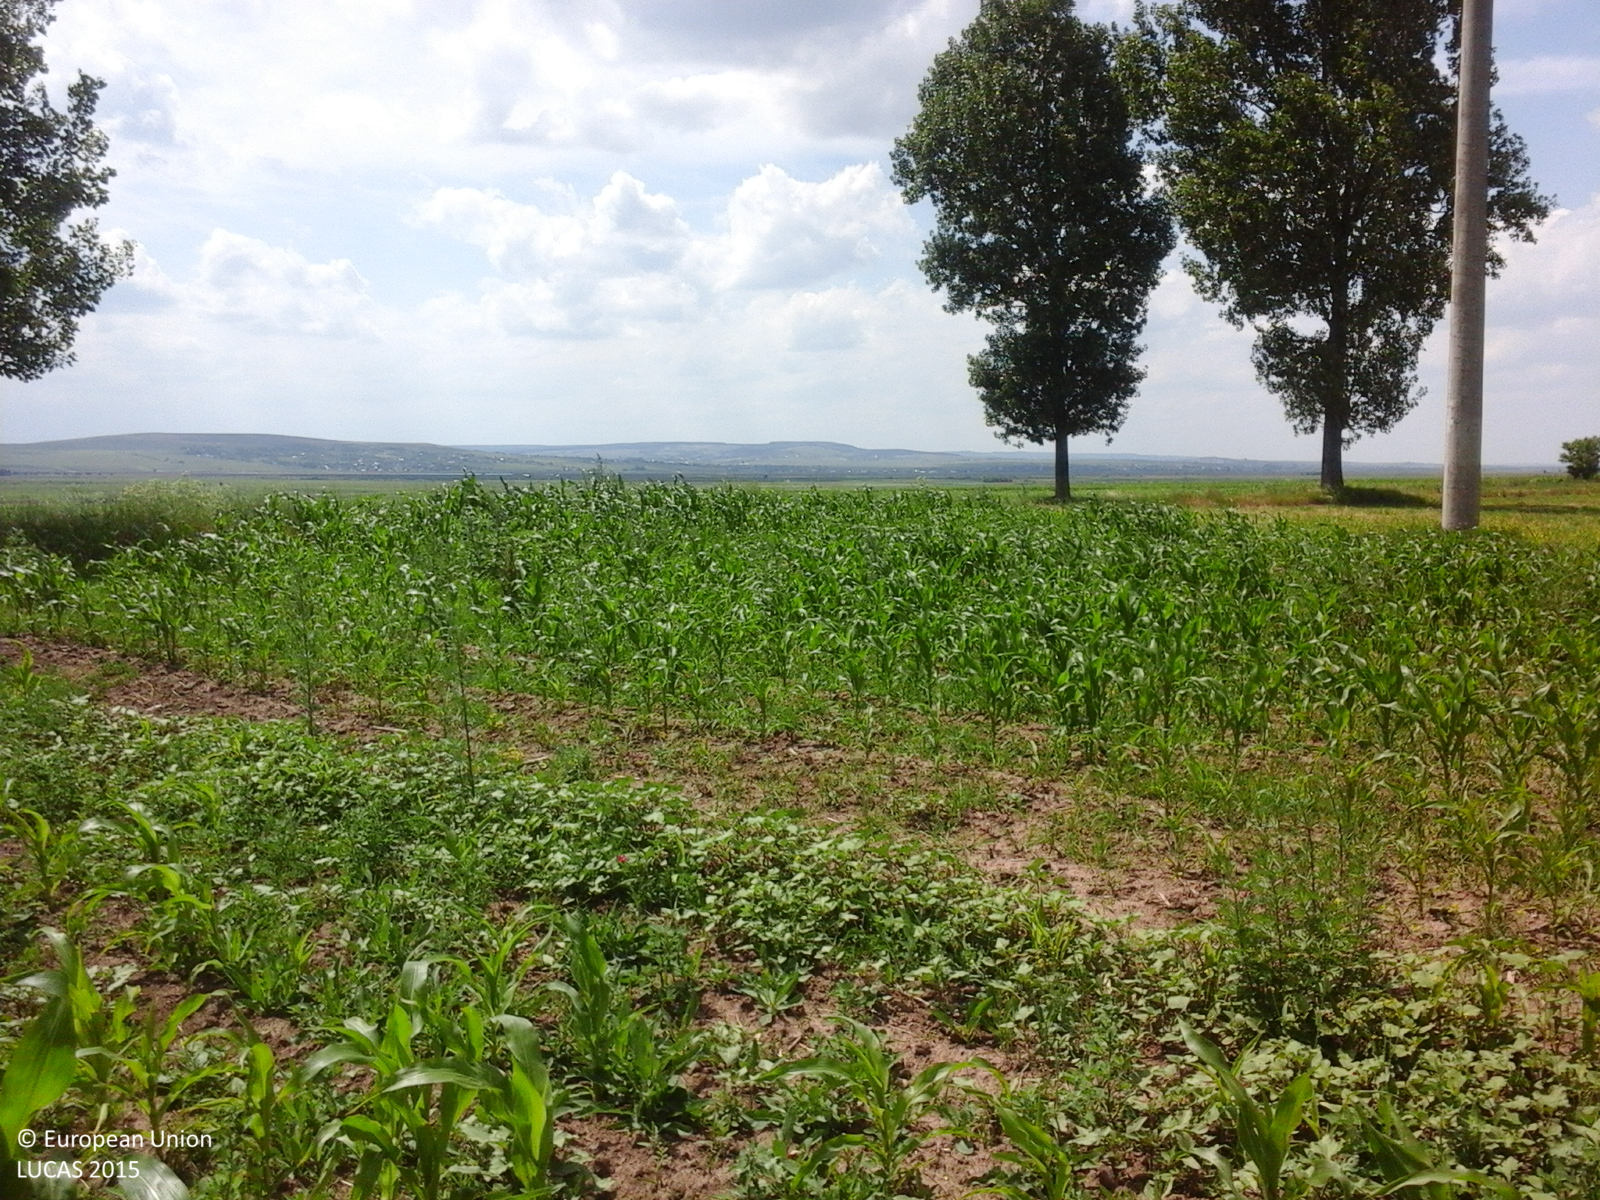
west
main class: Cropland
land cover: Maize
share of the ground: > 75 %
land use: Agriculture (excluding fallow land and kitchen gardens)
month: June
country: RO
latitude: 47.7899
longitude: 26.4138
